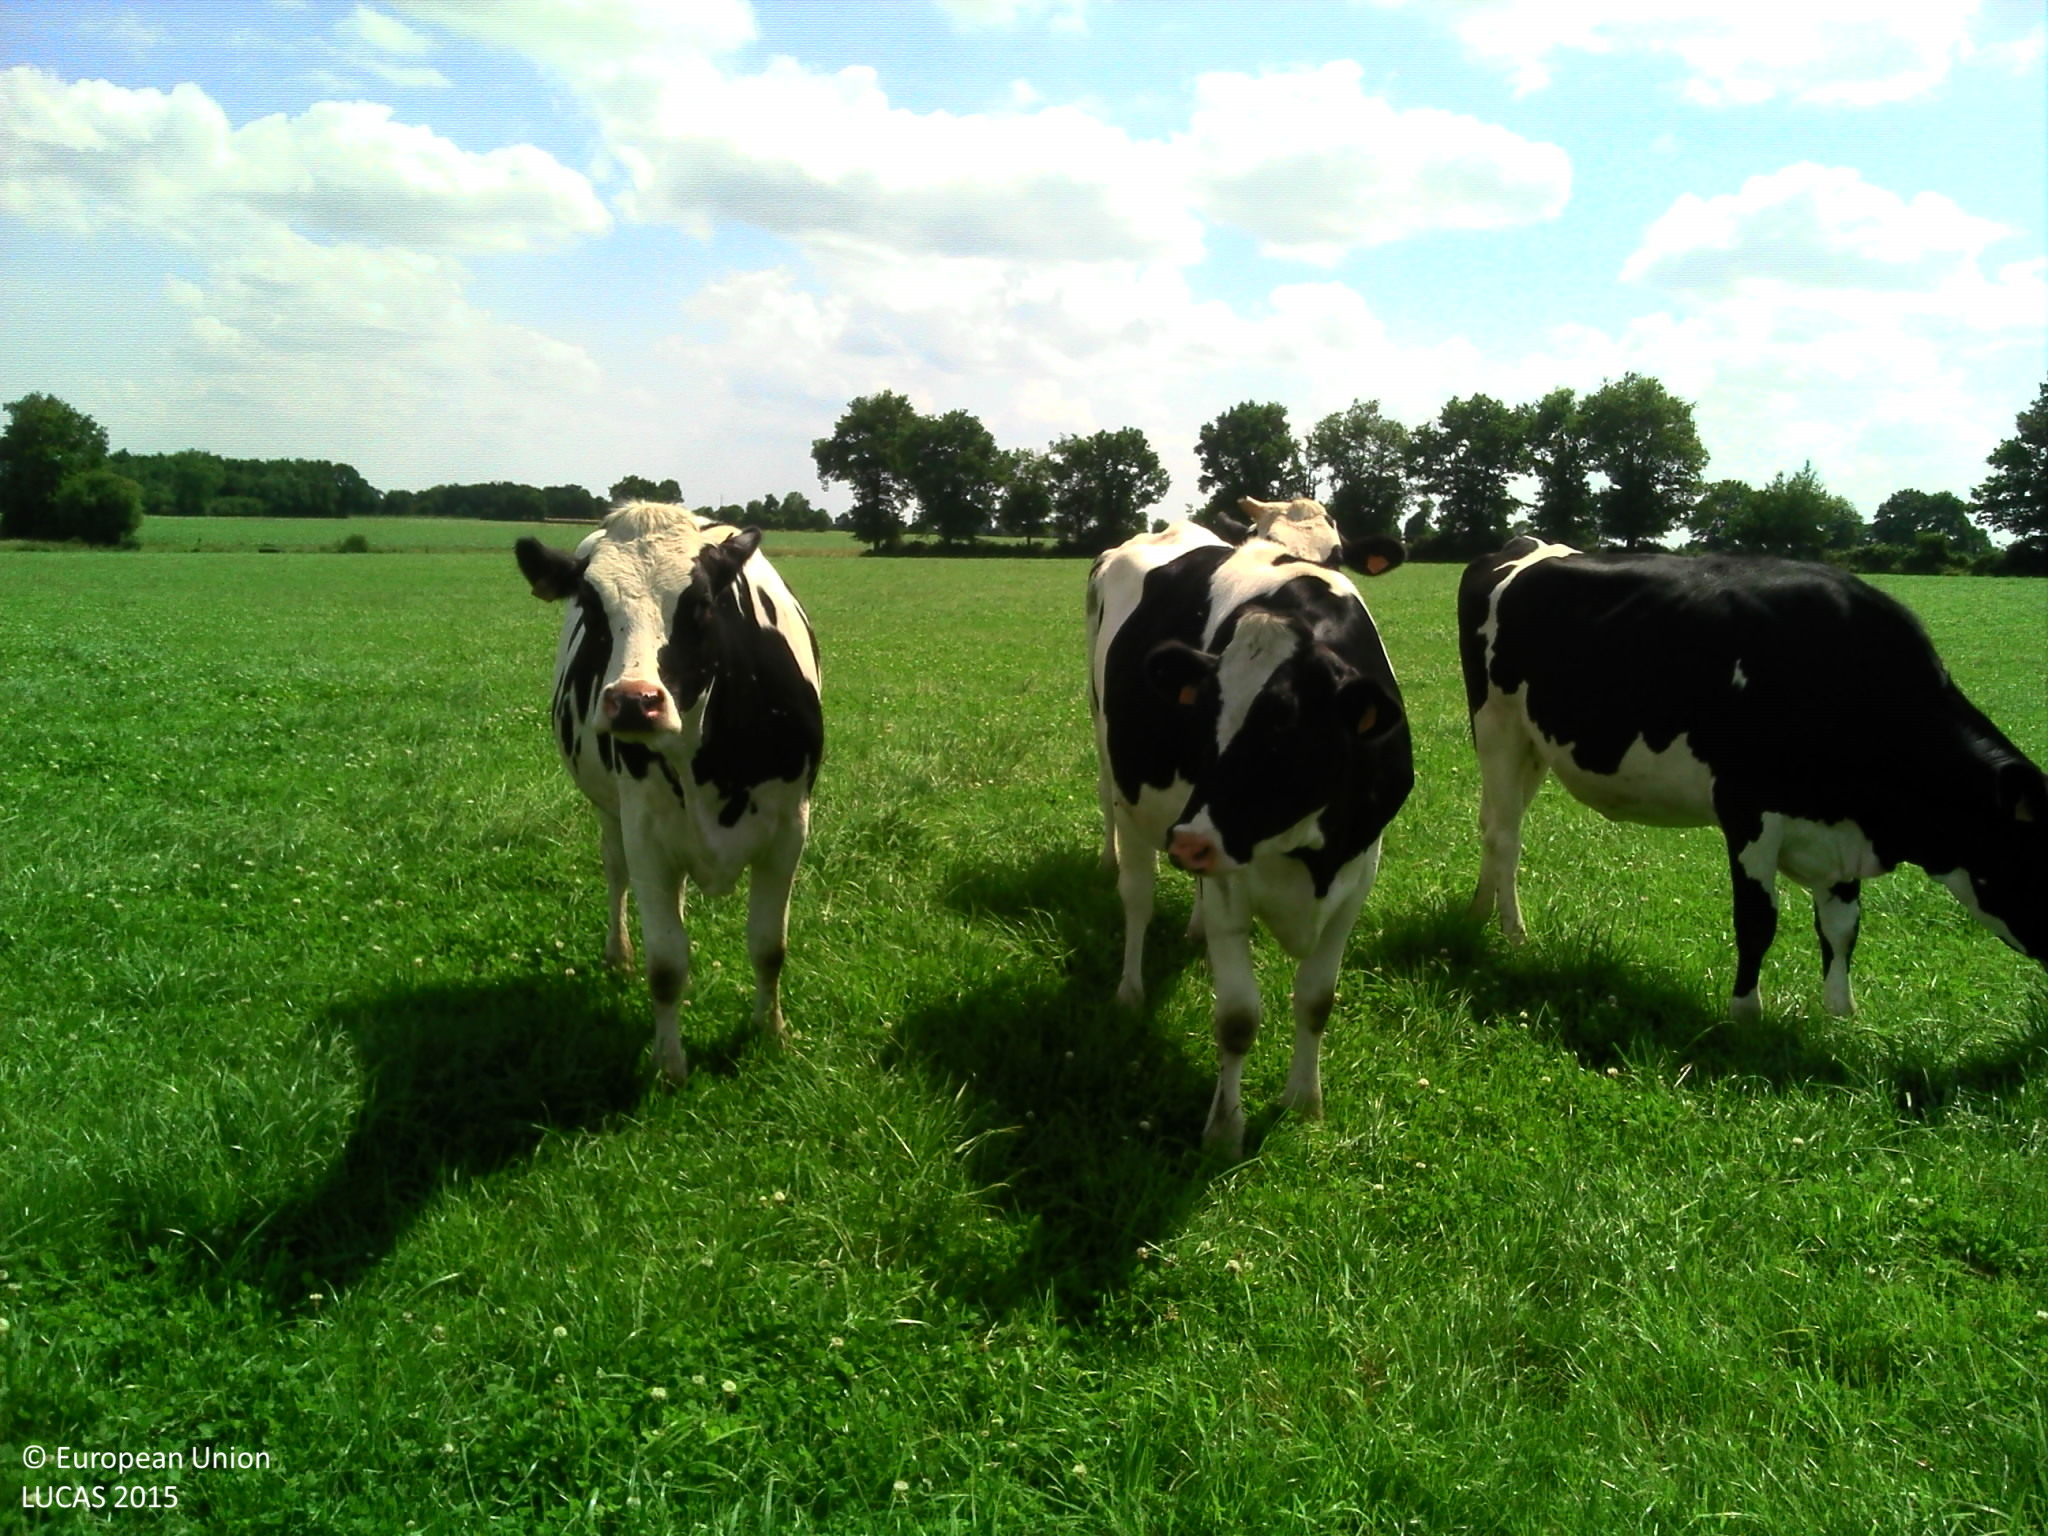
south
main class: Cropland
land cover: Temporary grasslands
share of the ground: > 75 %
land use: Agriculture (excluding fallow land and kitchen gardens)
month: June
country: FR
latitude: 46.8627
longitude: -1.4381
